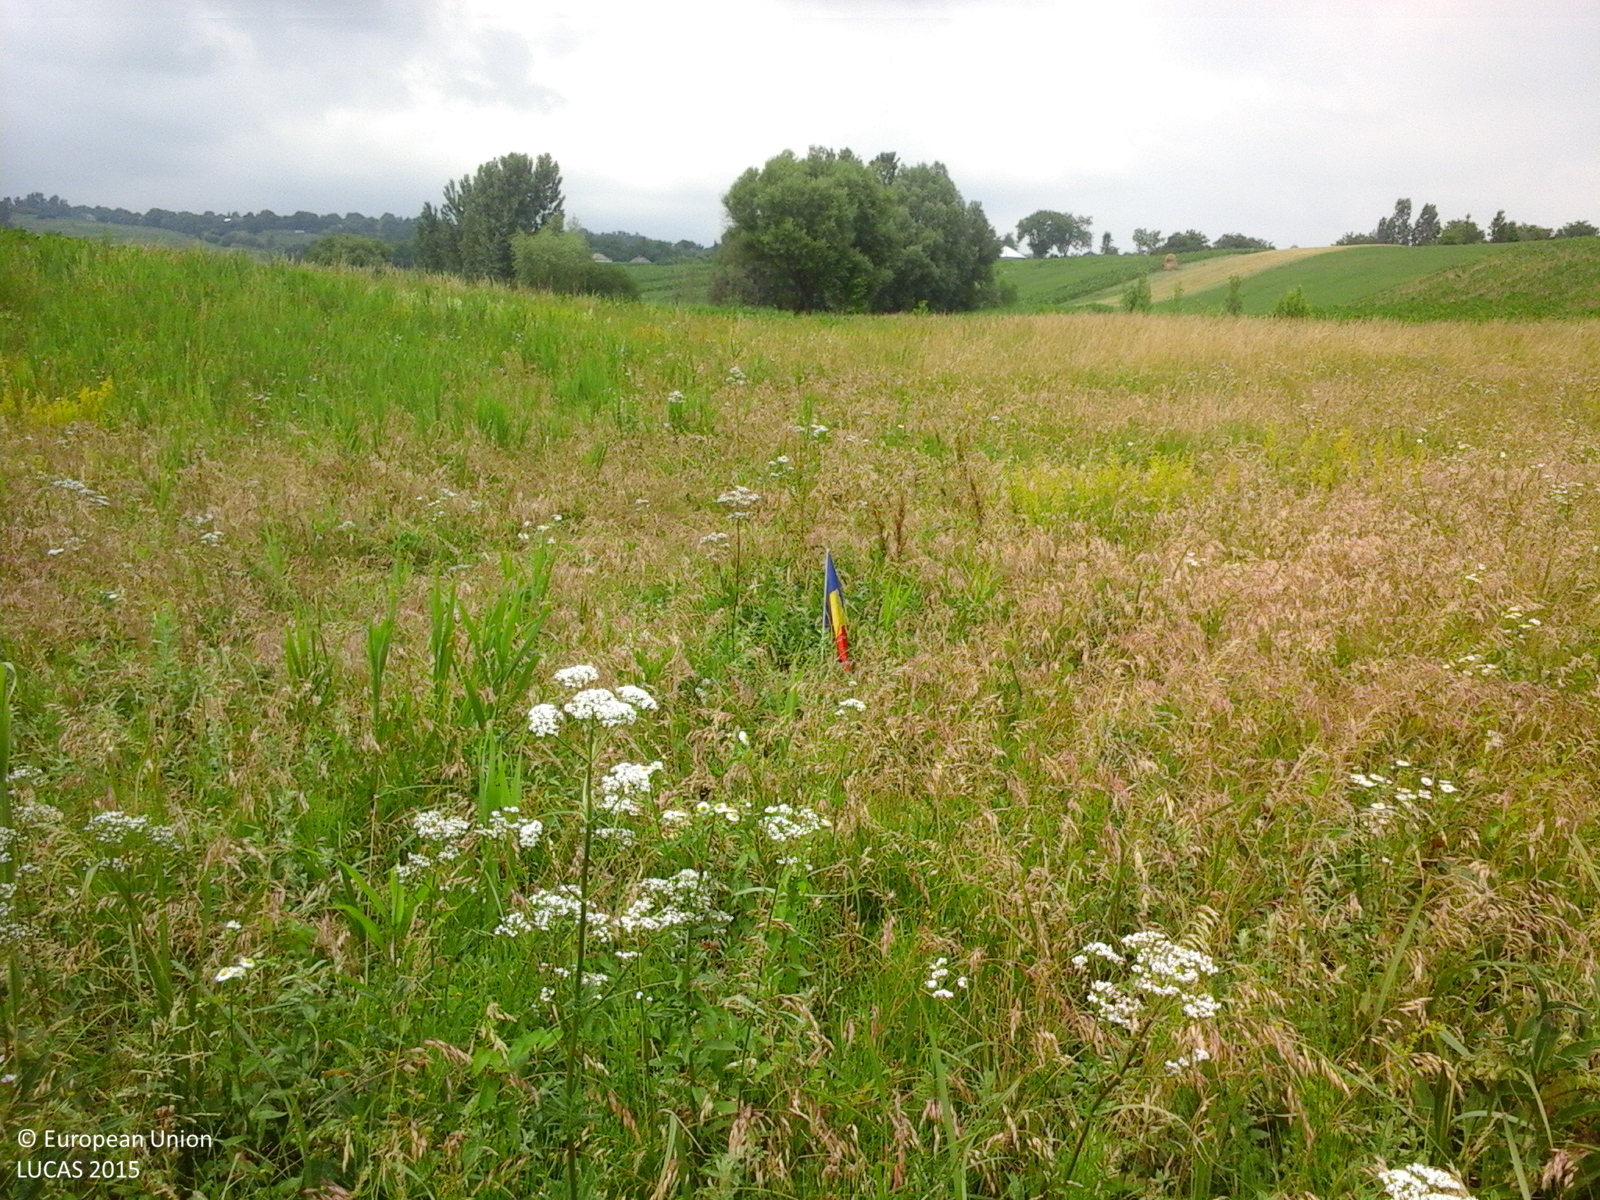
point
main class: Grassland
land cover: Grassland without tree/shrub cover
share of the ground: > 75 %
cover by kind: herbaceous plants 100 %
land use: Agriculture (excluding fallow land and kitchen gardens)
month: June
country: RO
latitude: 48.0506
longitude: 26.3893
